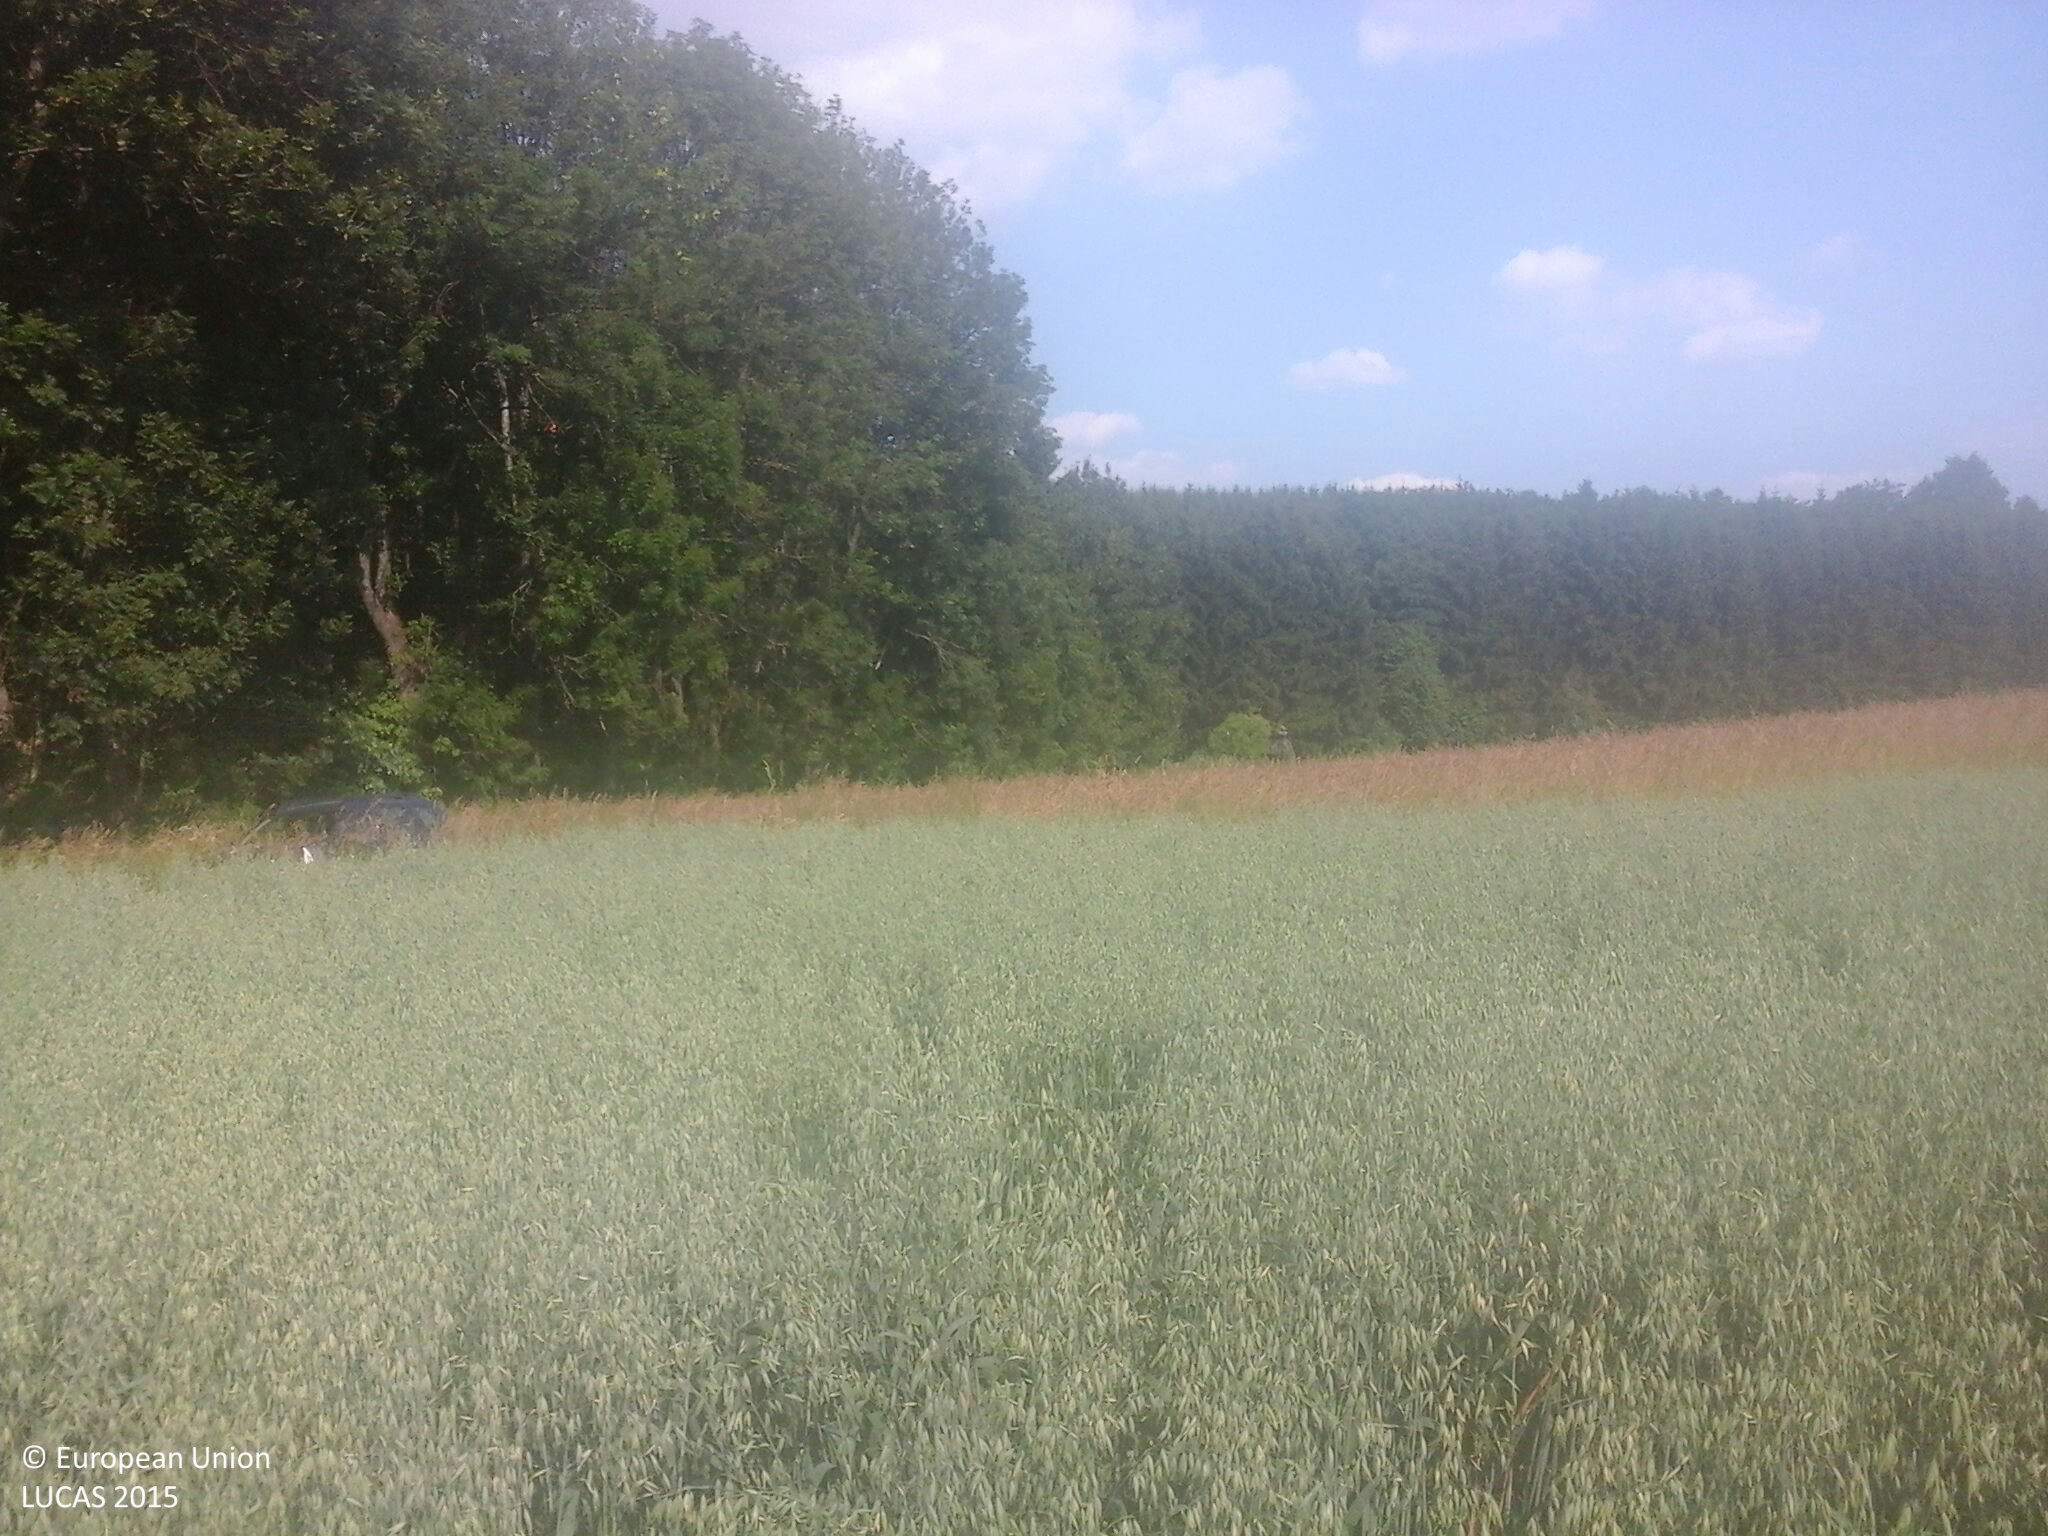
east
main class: Cropland
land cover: Oats
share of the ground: > 75 %
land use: Agriculture (excluding fallow land and kitchen gardens)
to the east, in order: Oats; Grassland without tree/shrub cover; Broadleaved woodland; Rivers and streams; Broadleaved woodland
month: July
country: HU
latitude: 47.2905
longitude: 17.8770
